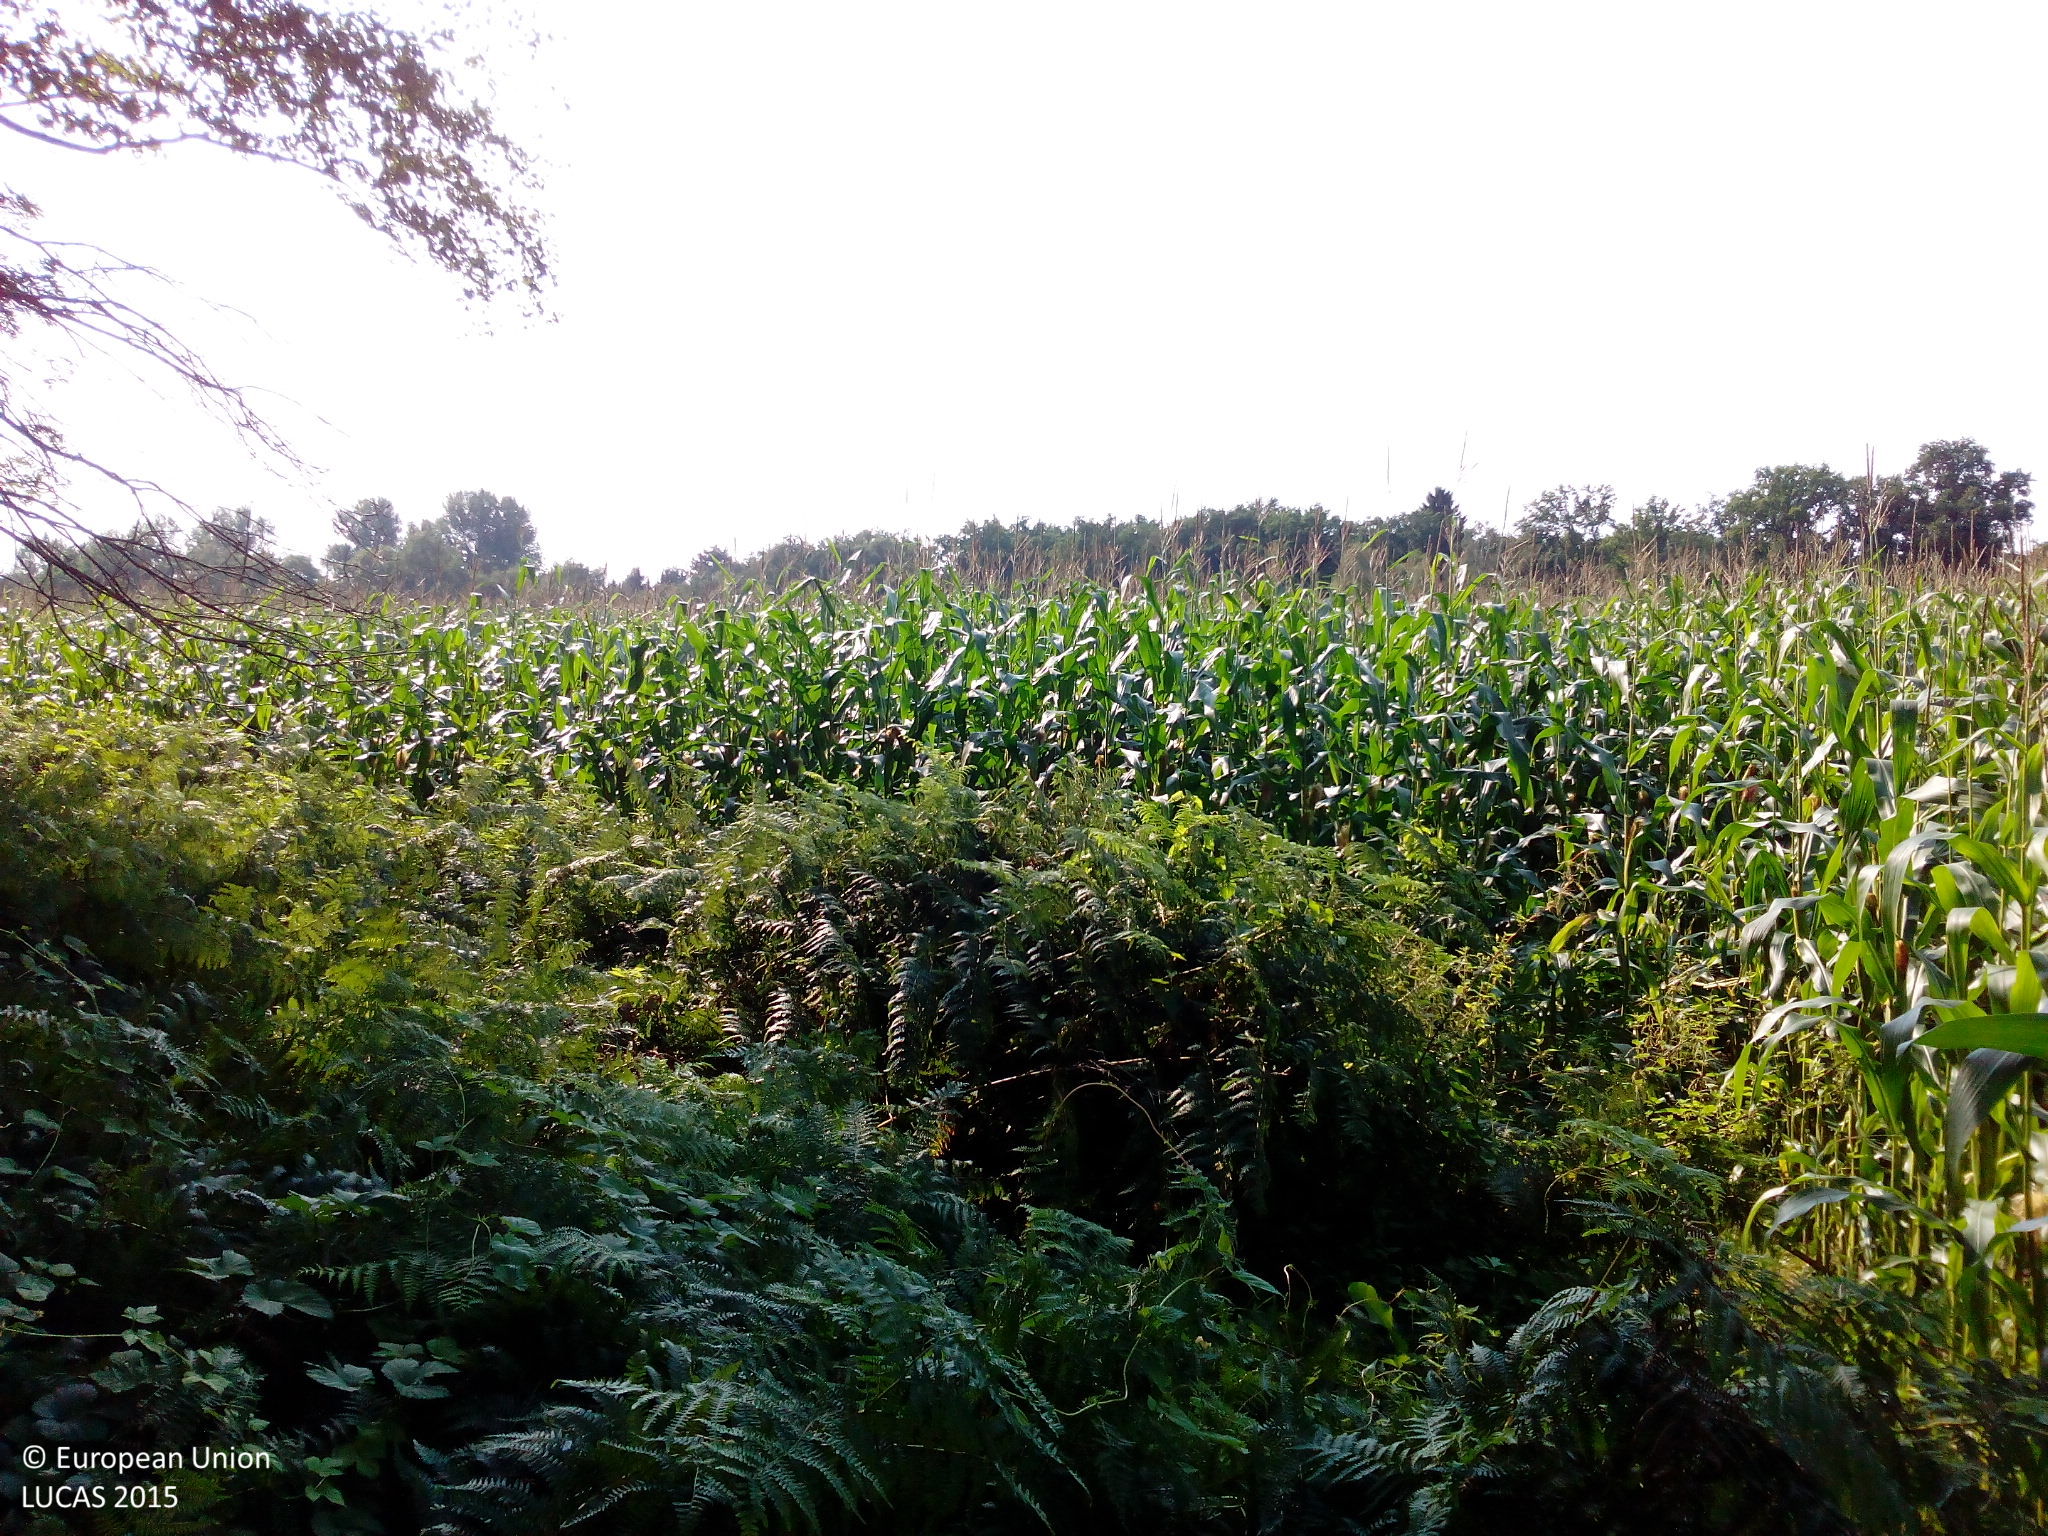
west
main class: Cropland
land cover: Maize
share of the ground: > 75 %
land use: Agriculture (excluding fallow land and kitchen gardens)
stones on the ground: < 10 %
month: August
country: DE
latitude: 52.0366
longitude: 7.9741
